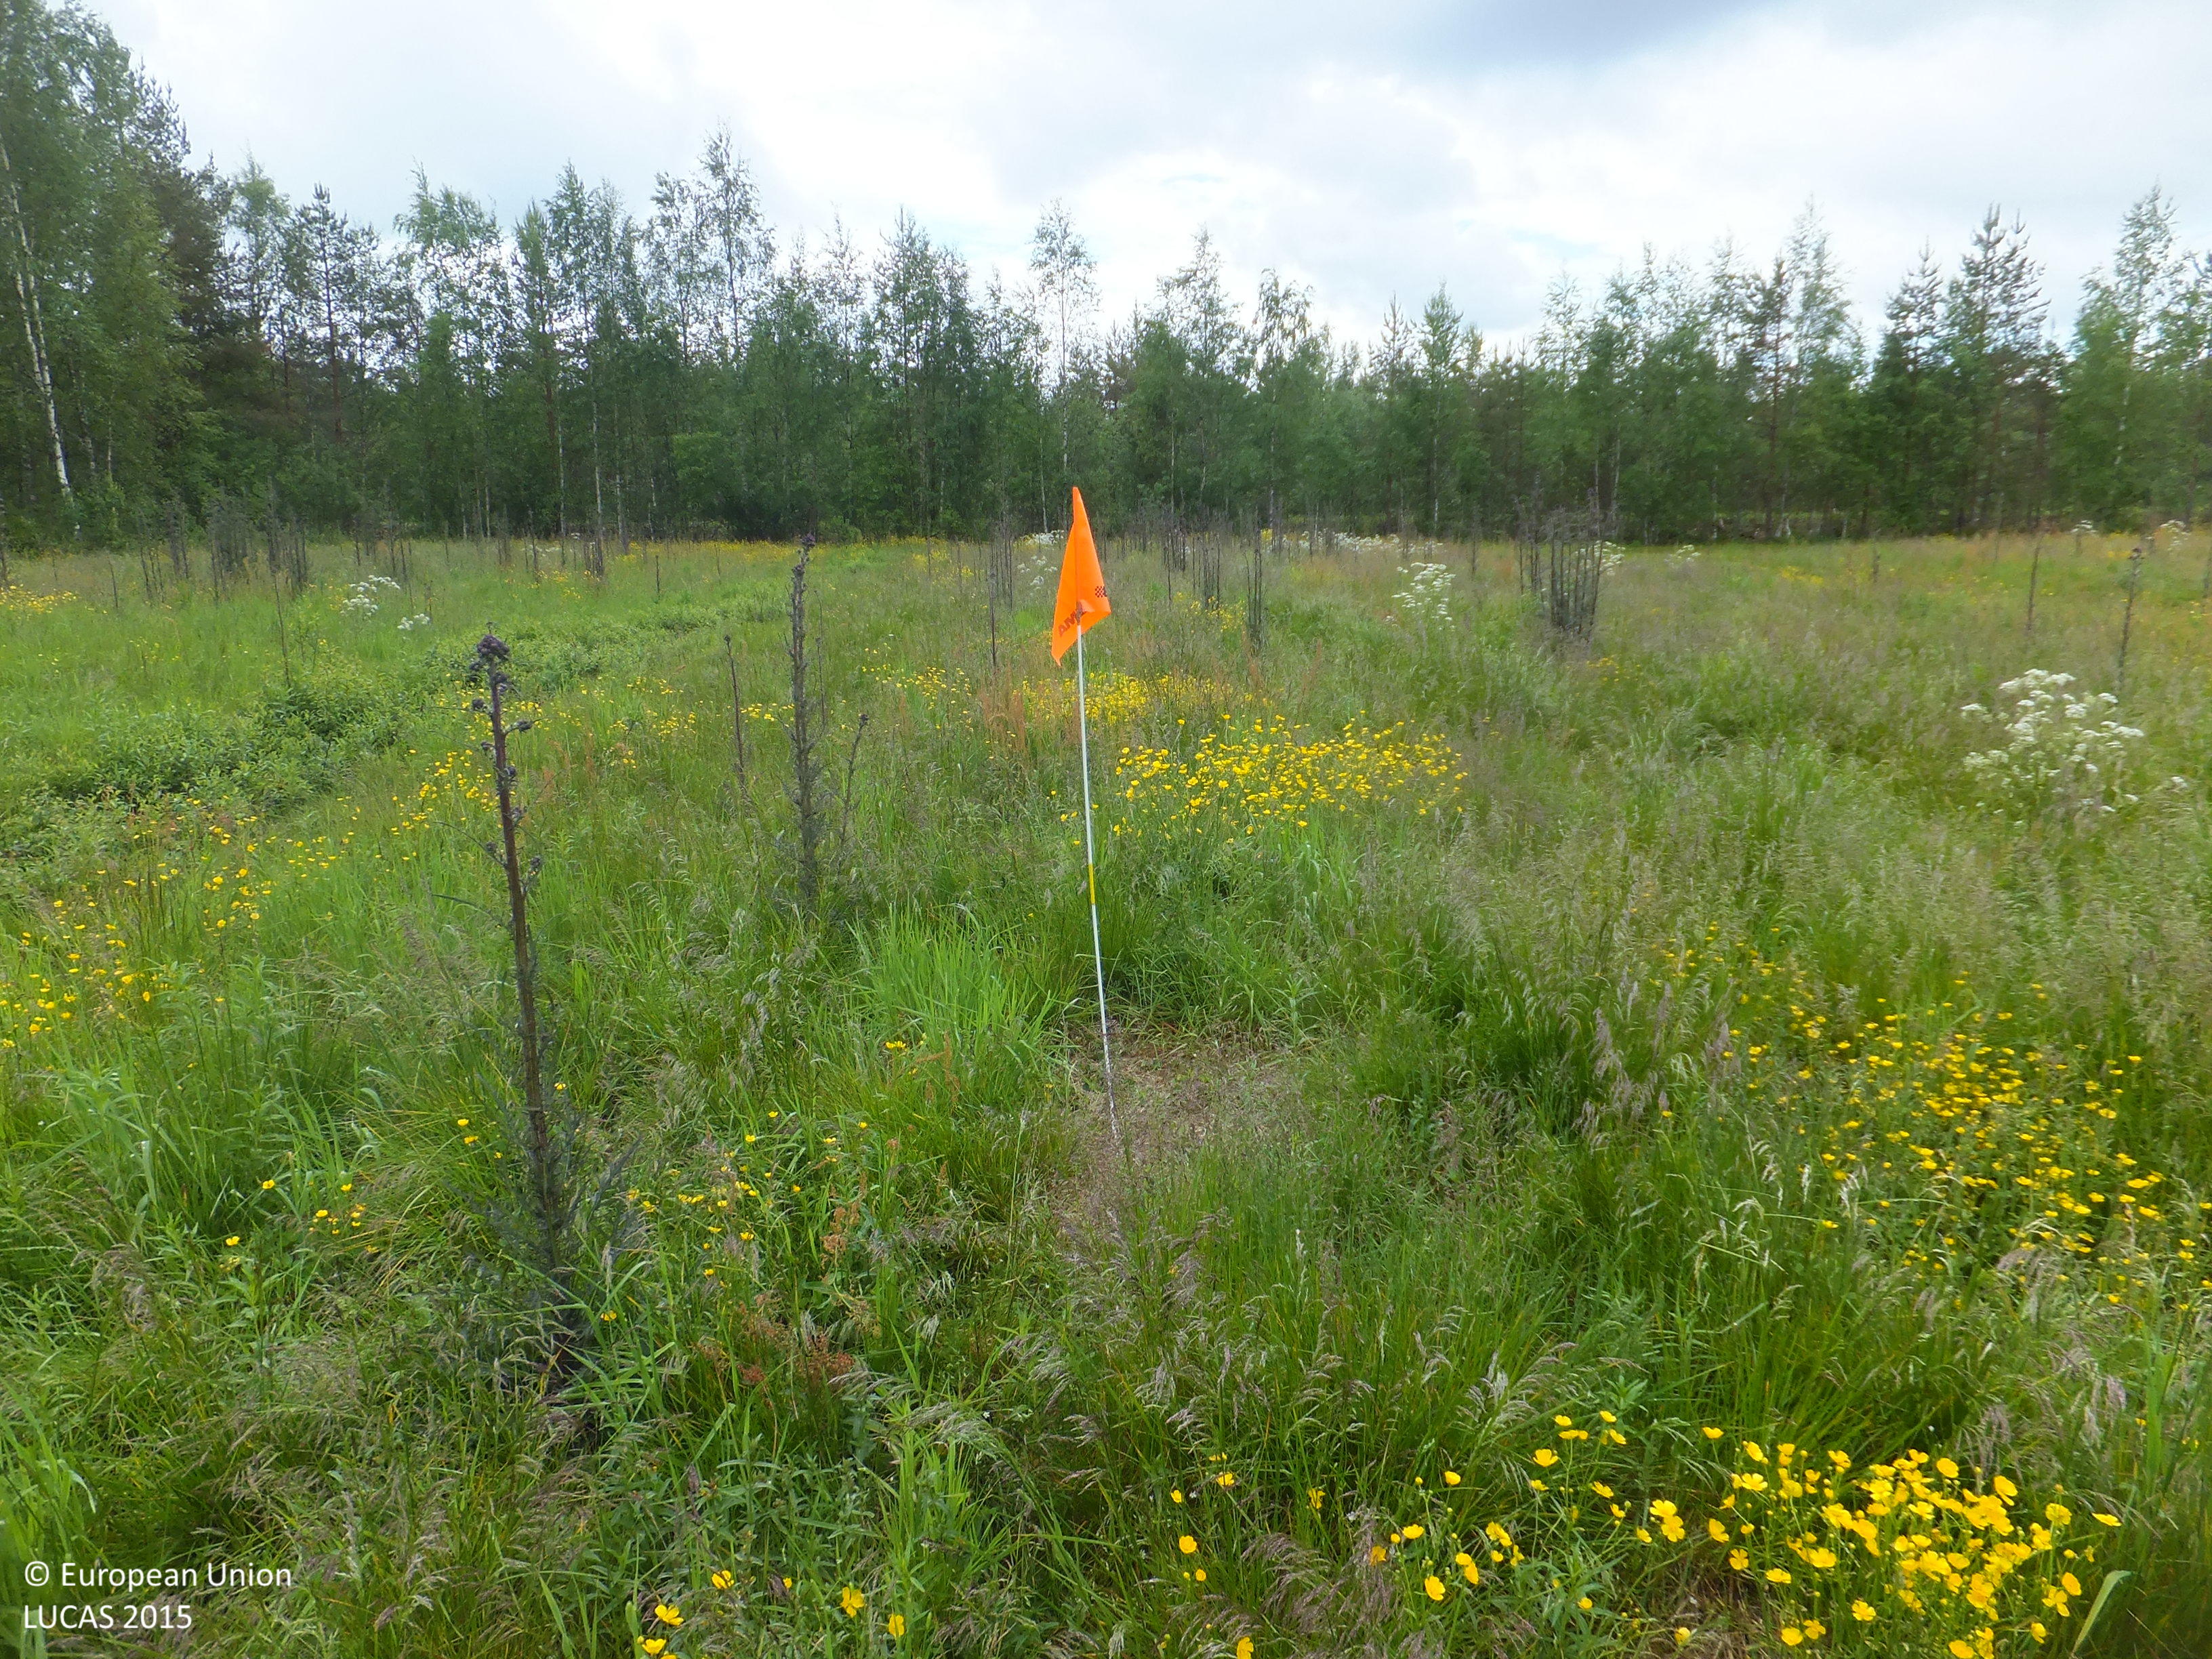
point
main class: Grassland
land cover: Grassland without tree/shrub cover
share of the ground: > 75 %
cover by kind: herbaceous plants 95 %, consolidated bare surface 5 %
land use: Agriculture (excluding fallow land and kitchen gardens)
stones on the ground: < 10 %
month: June
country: FI
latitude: 63.3609
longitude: 24.0870
